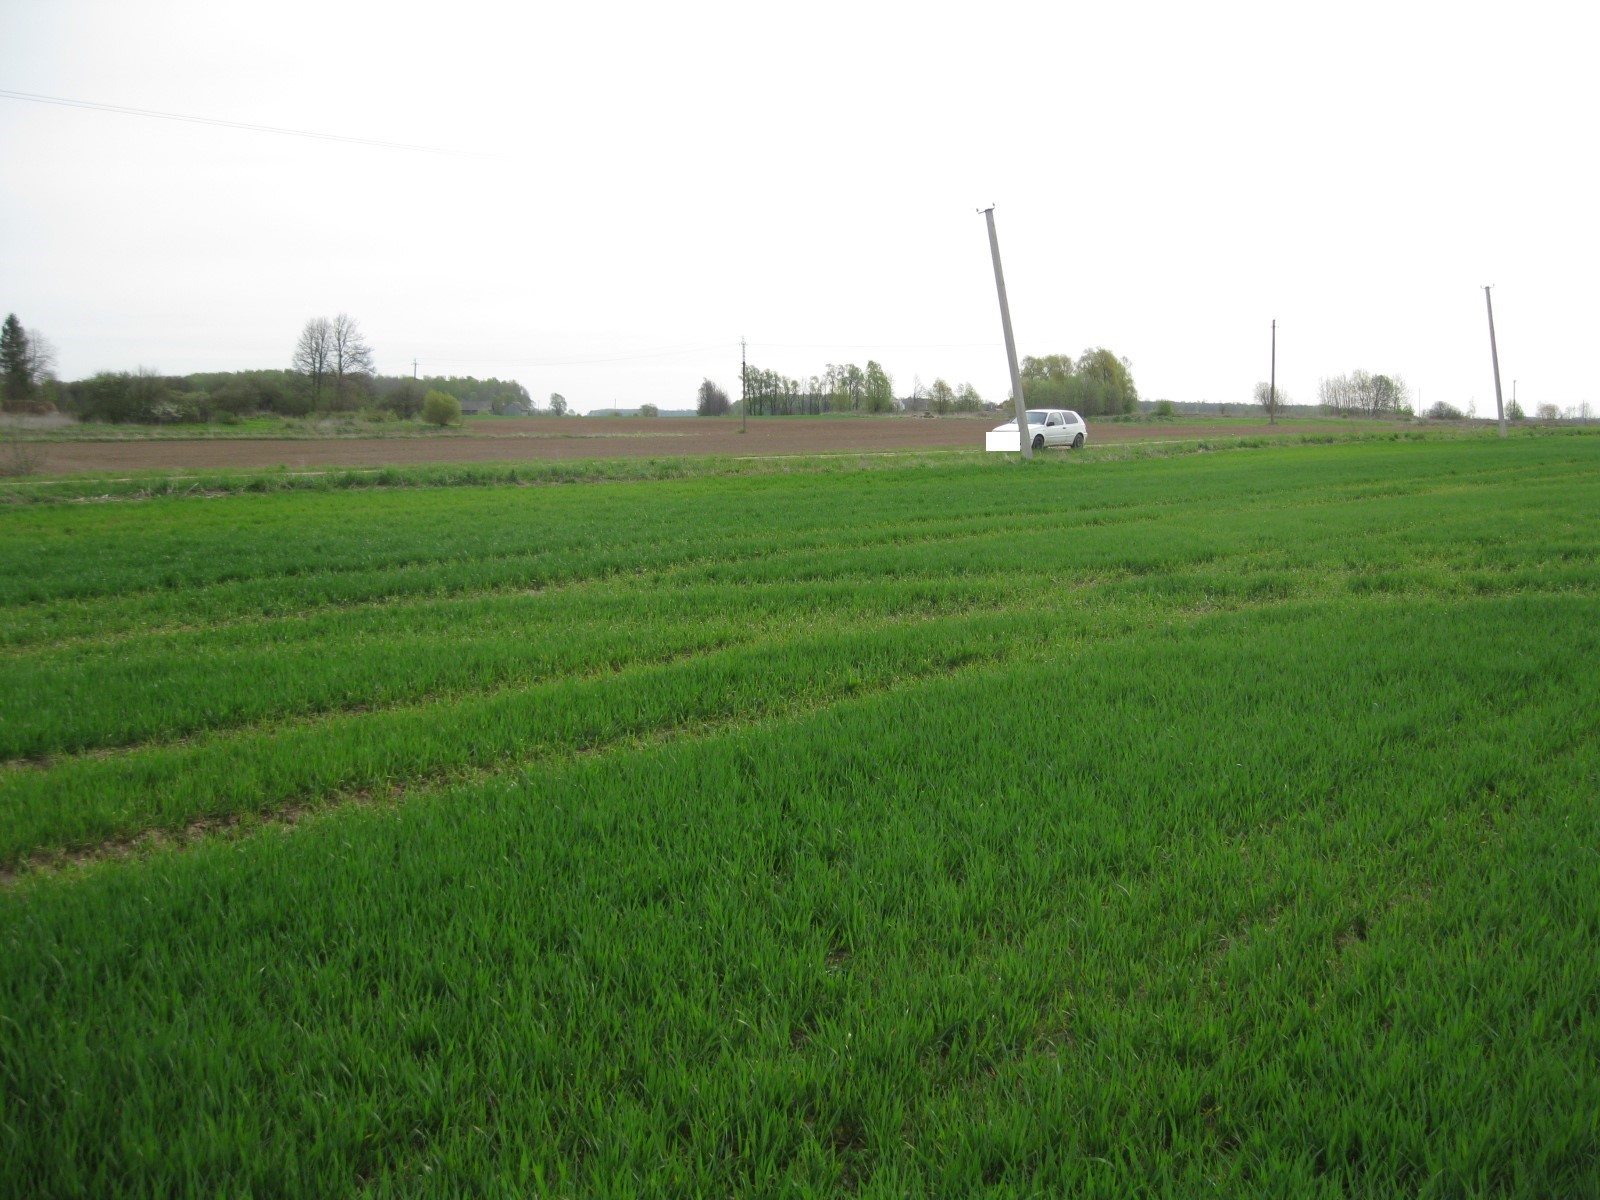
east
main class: Cropland
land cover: Common wheat
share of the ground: > 75 %
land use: Agriculture (excluding fallow land and kitchen gardens)
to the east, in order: Common wheat; Electric lines; Grassland without tree/shrub cover; Paved roads, cycling and walking lanes; Grass margins; Mixed cereals for fodder; Electric lines; Spontaneously vegetated surfaces; Ditches and canals; Spontaneously vegetated surfaces; Maize
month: May
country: LT
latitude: 56.2572
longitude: 24.4793
